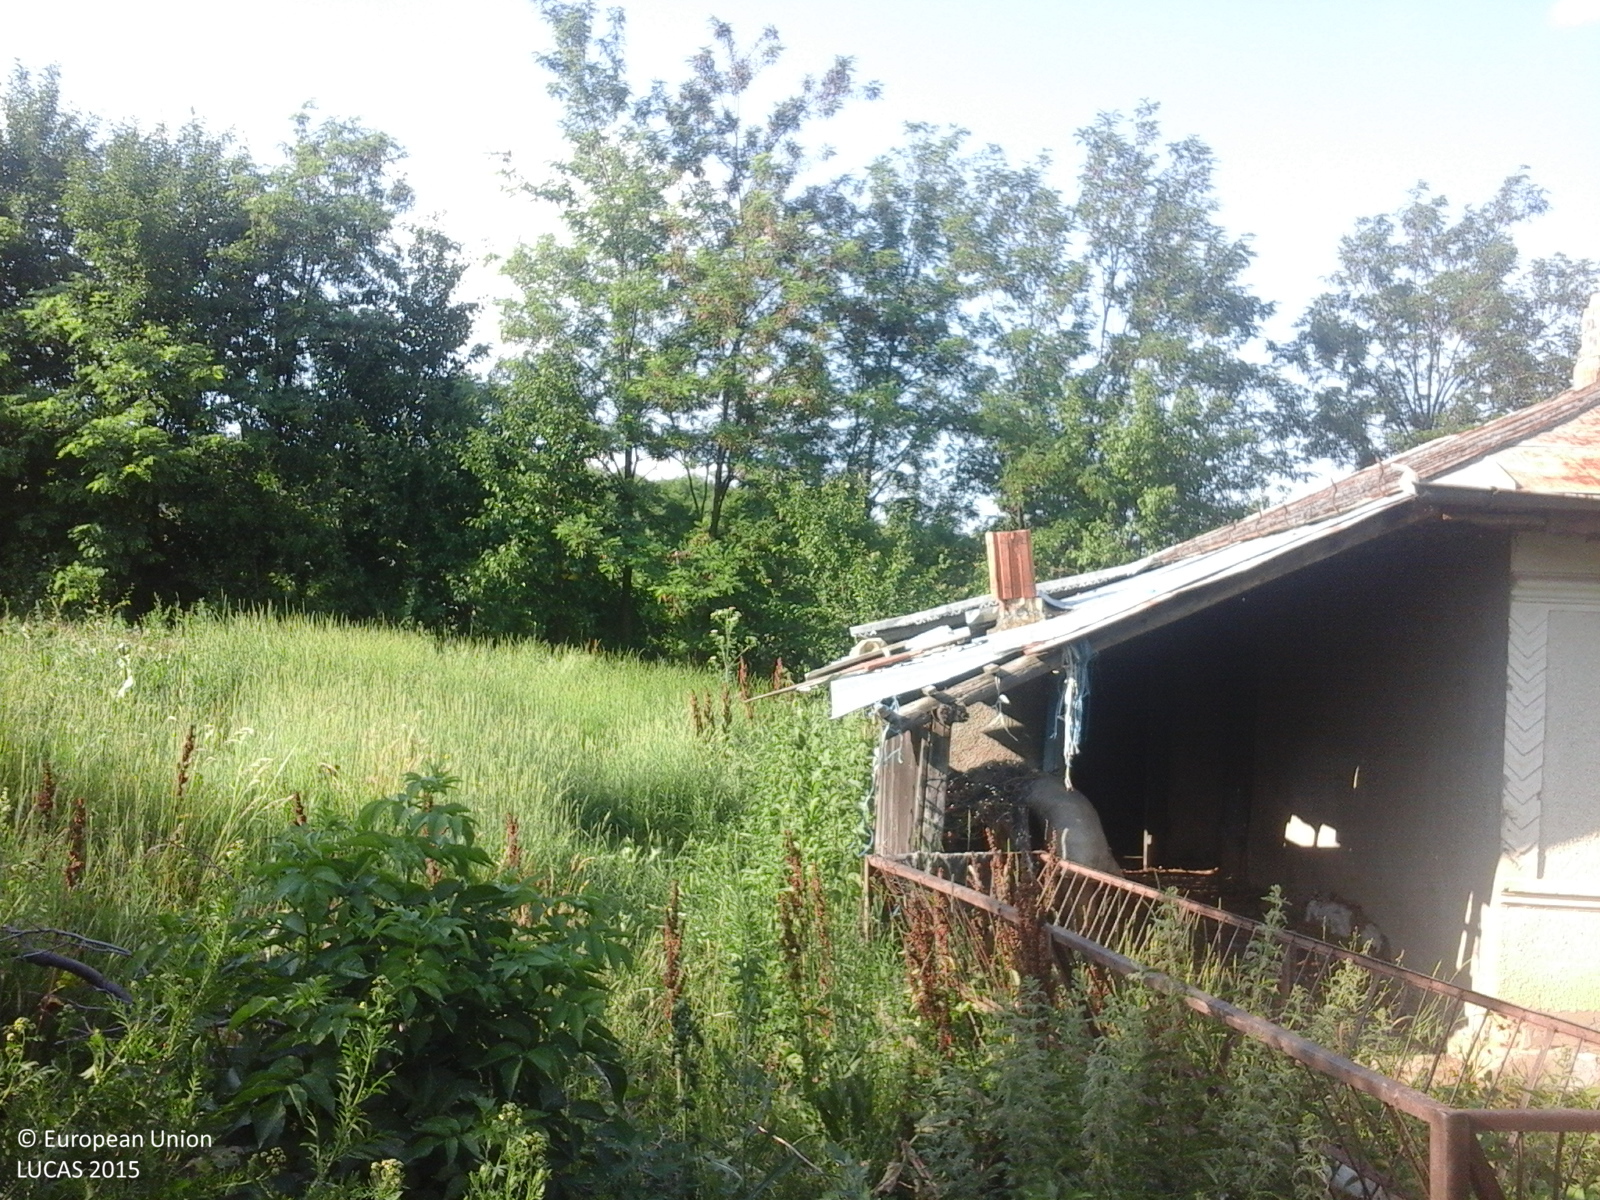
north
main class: Grassland
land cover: Grassland without tree/shrub cover
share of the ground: > 75 %
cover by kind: herbaceous plants 100 %
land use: Agriculture (excluding fallow land and kitchen gardens)
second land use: Residential
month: June
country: RO
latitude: 47.1618
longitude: 27.0255
